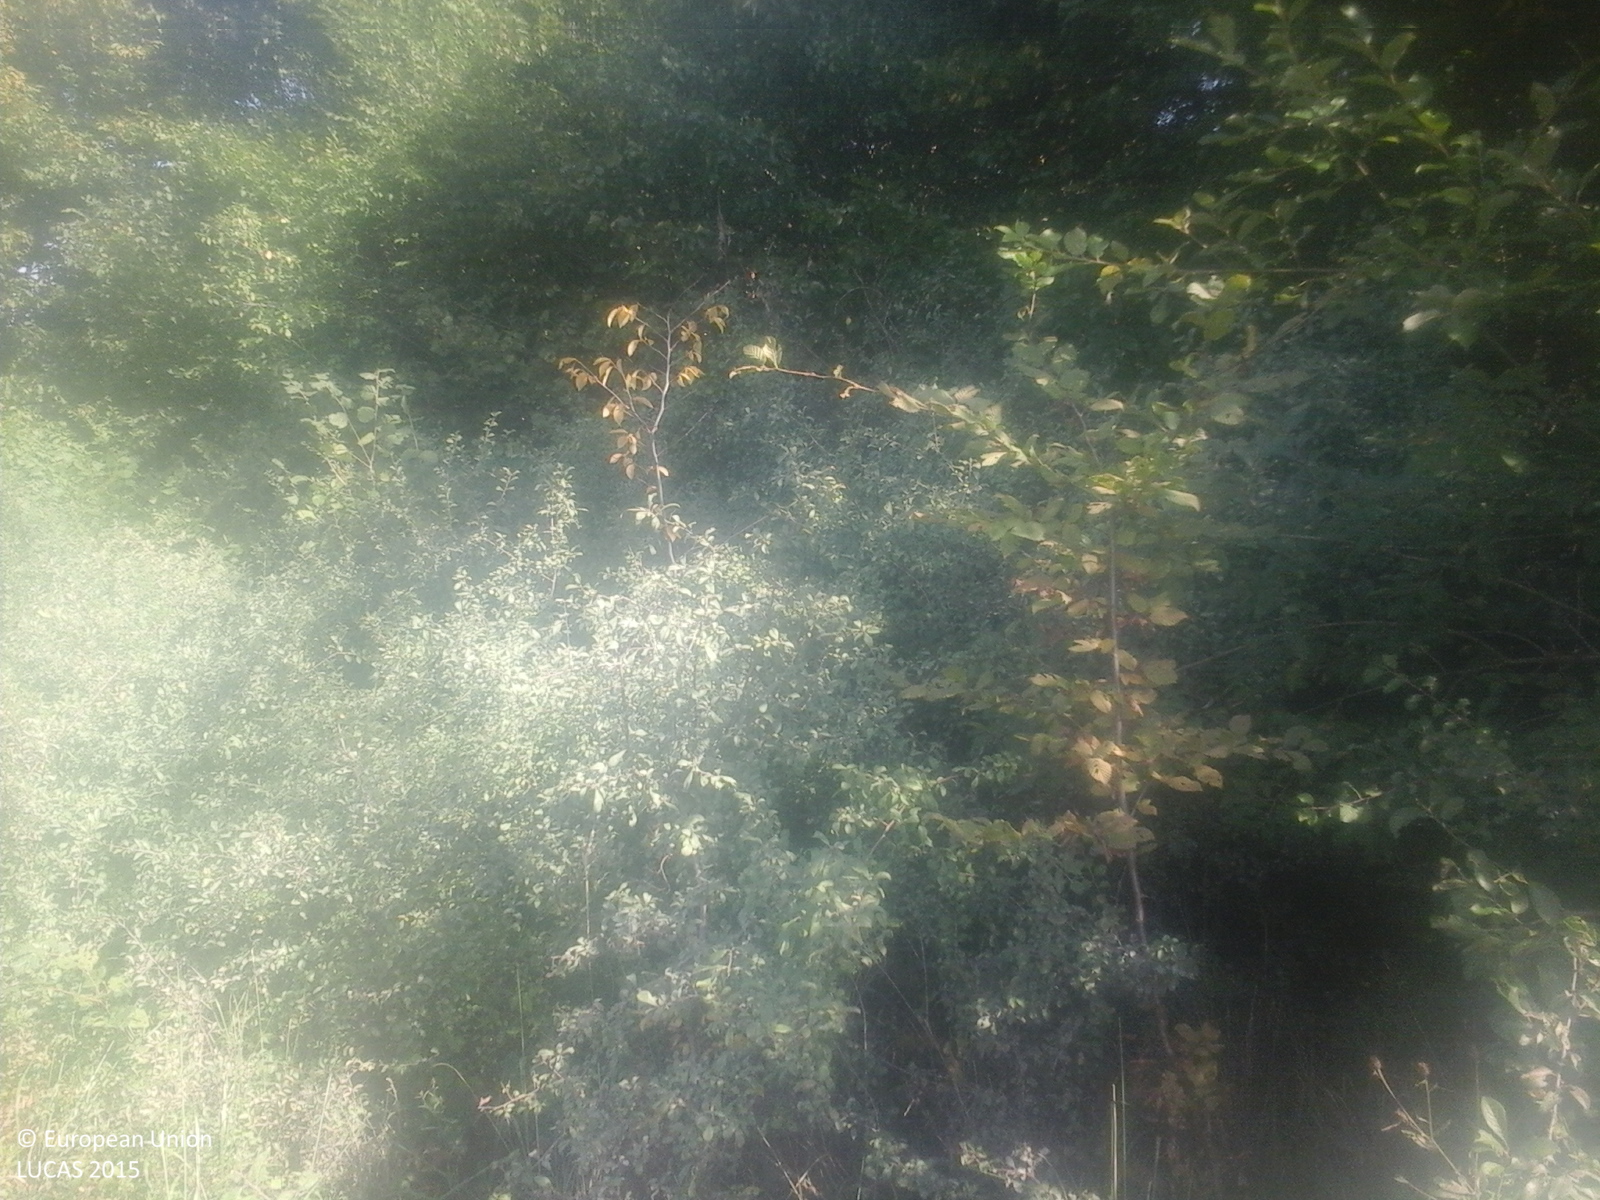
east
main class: Woodland
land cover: Other mixed woodland
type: mesophytic deciduous forest
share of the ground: > 75 %
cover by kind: broadleaved forest trees 70 %, coniferous forest trees 30 %
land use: Forestry
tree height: > 5 m
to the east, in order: Other mixed woodland
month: September
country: RO
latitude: 46.9680
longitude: 23.6504
